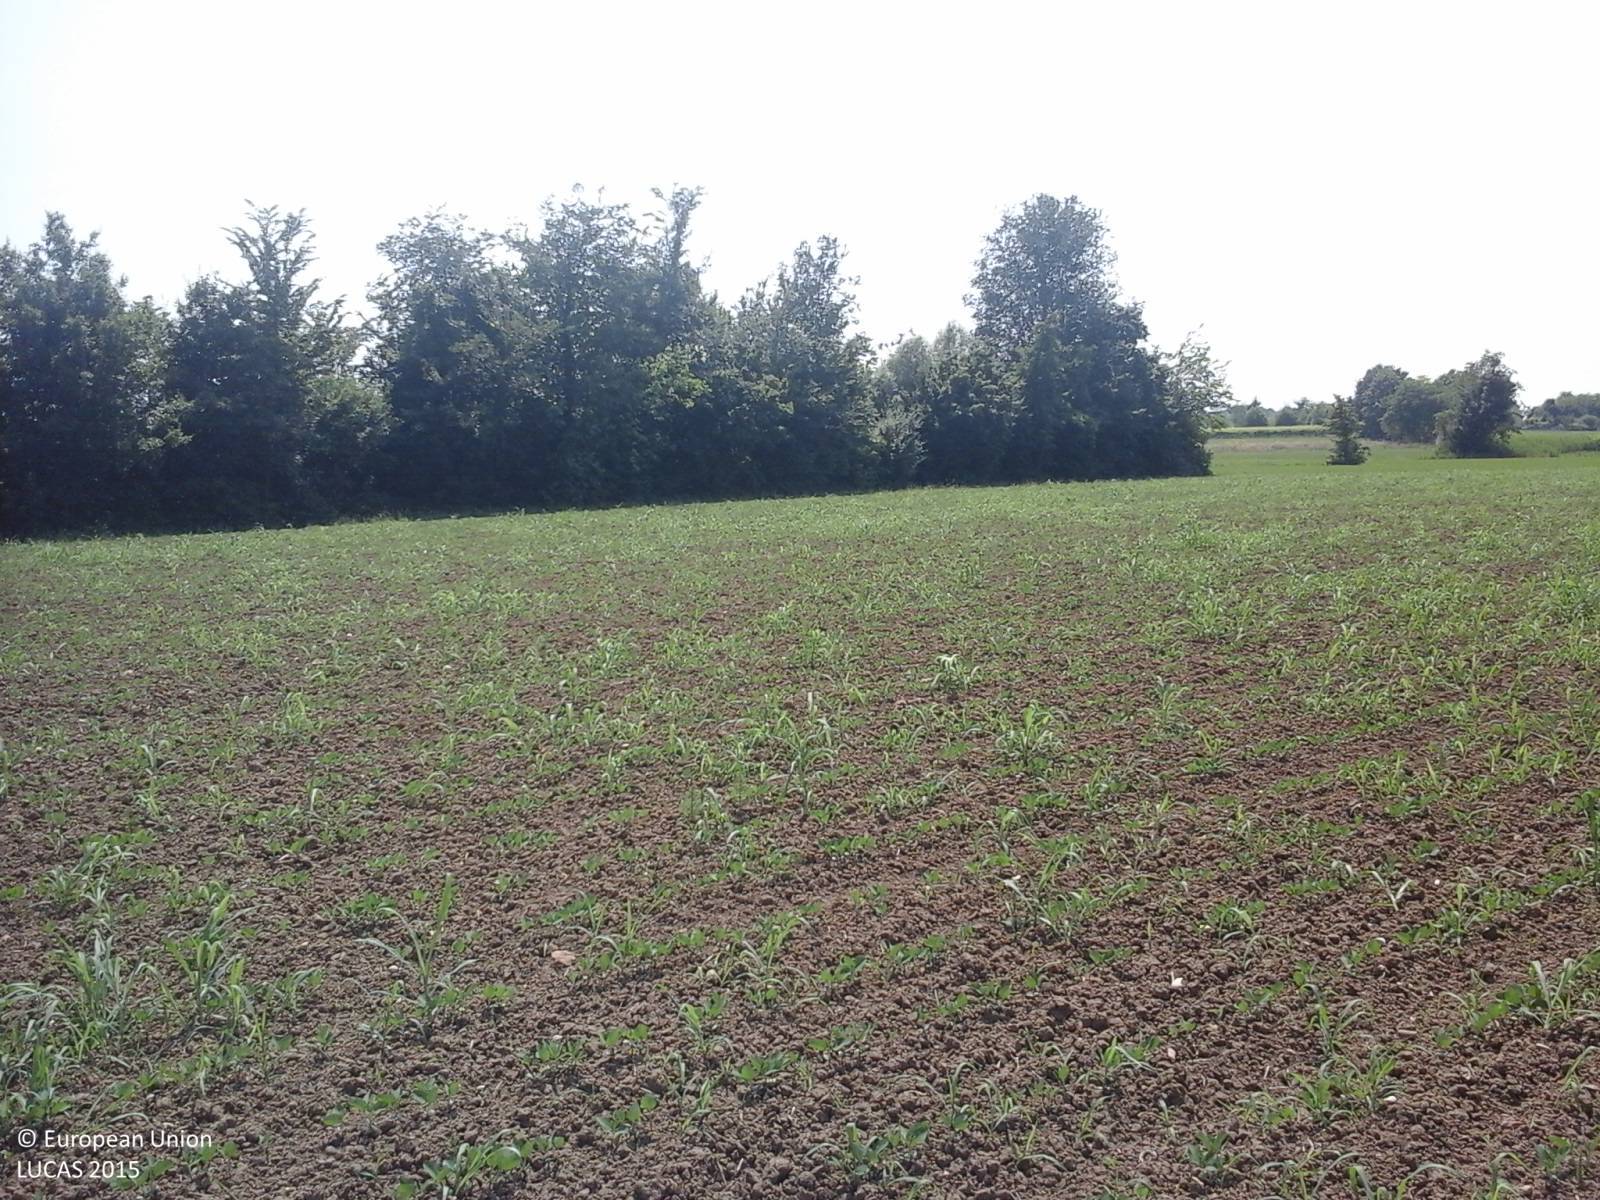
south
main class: Cropland
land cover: Soya
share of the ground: < 10 %
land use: Agriculture (excluding fallow land and kitchen gardens)
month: June
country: IT
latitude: 45.8712
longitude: 12.5087
